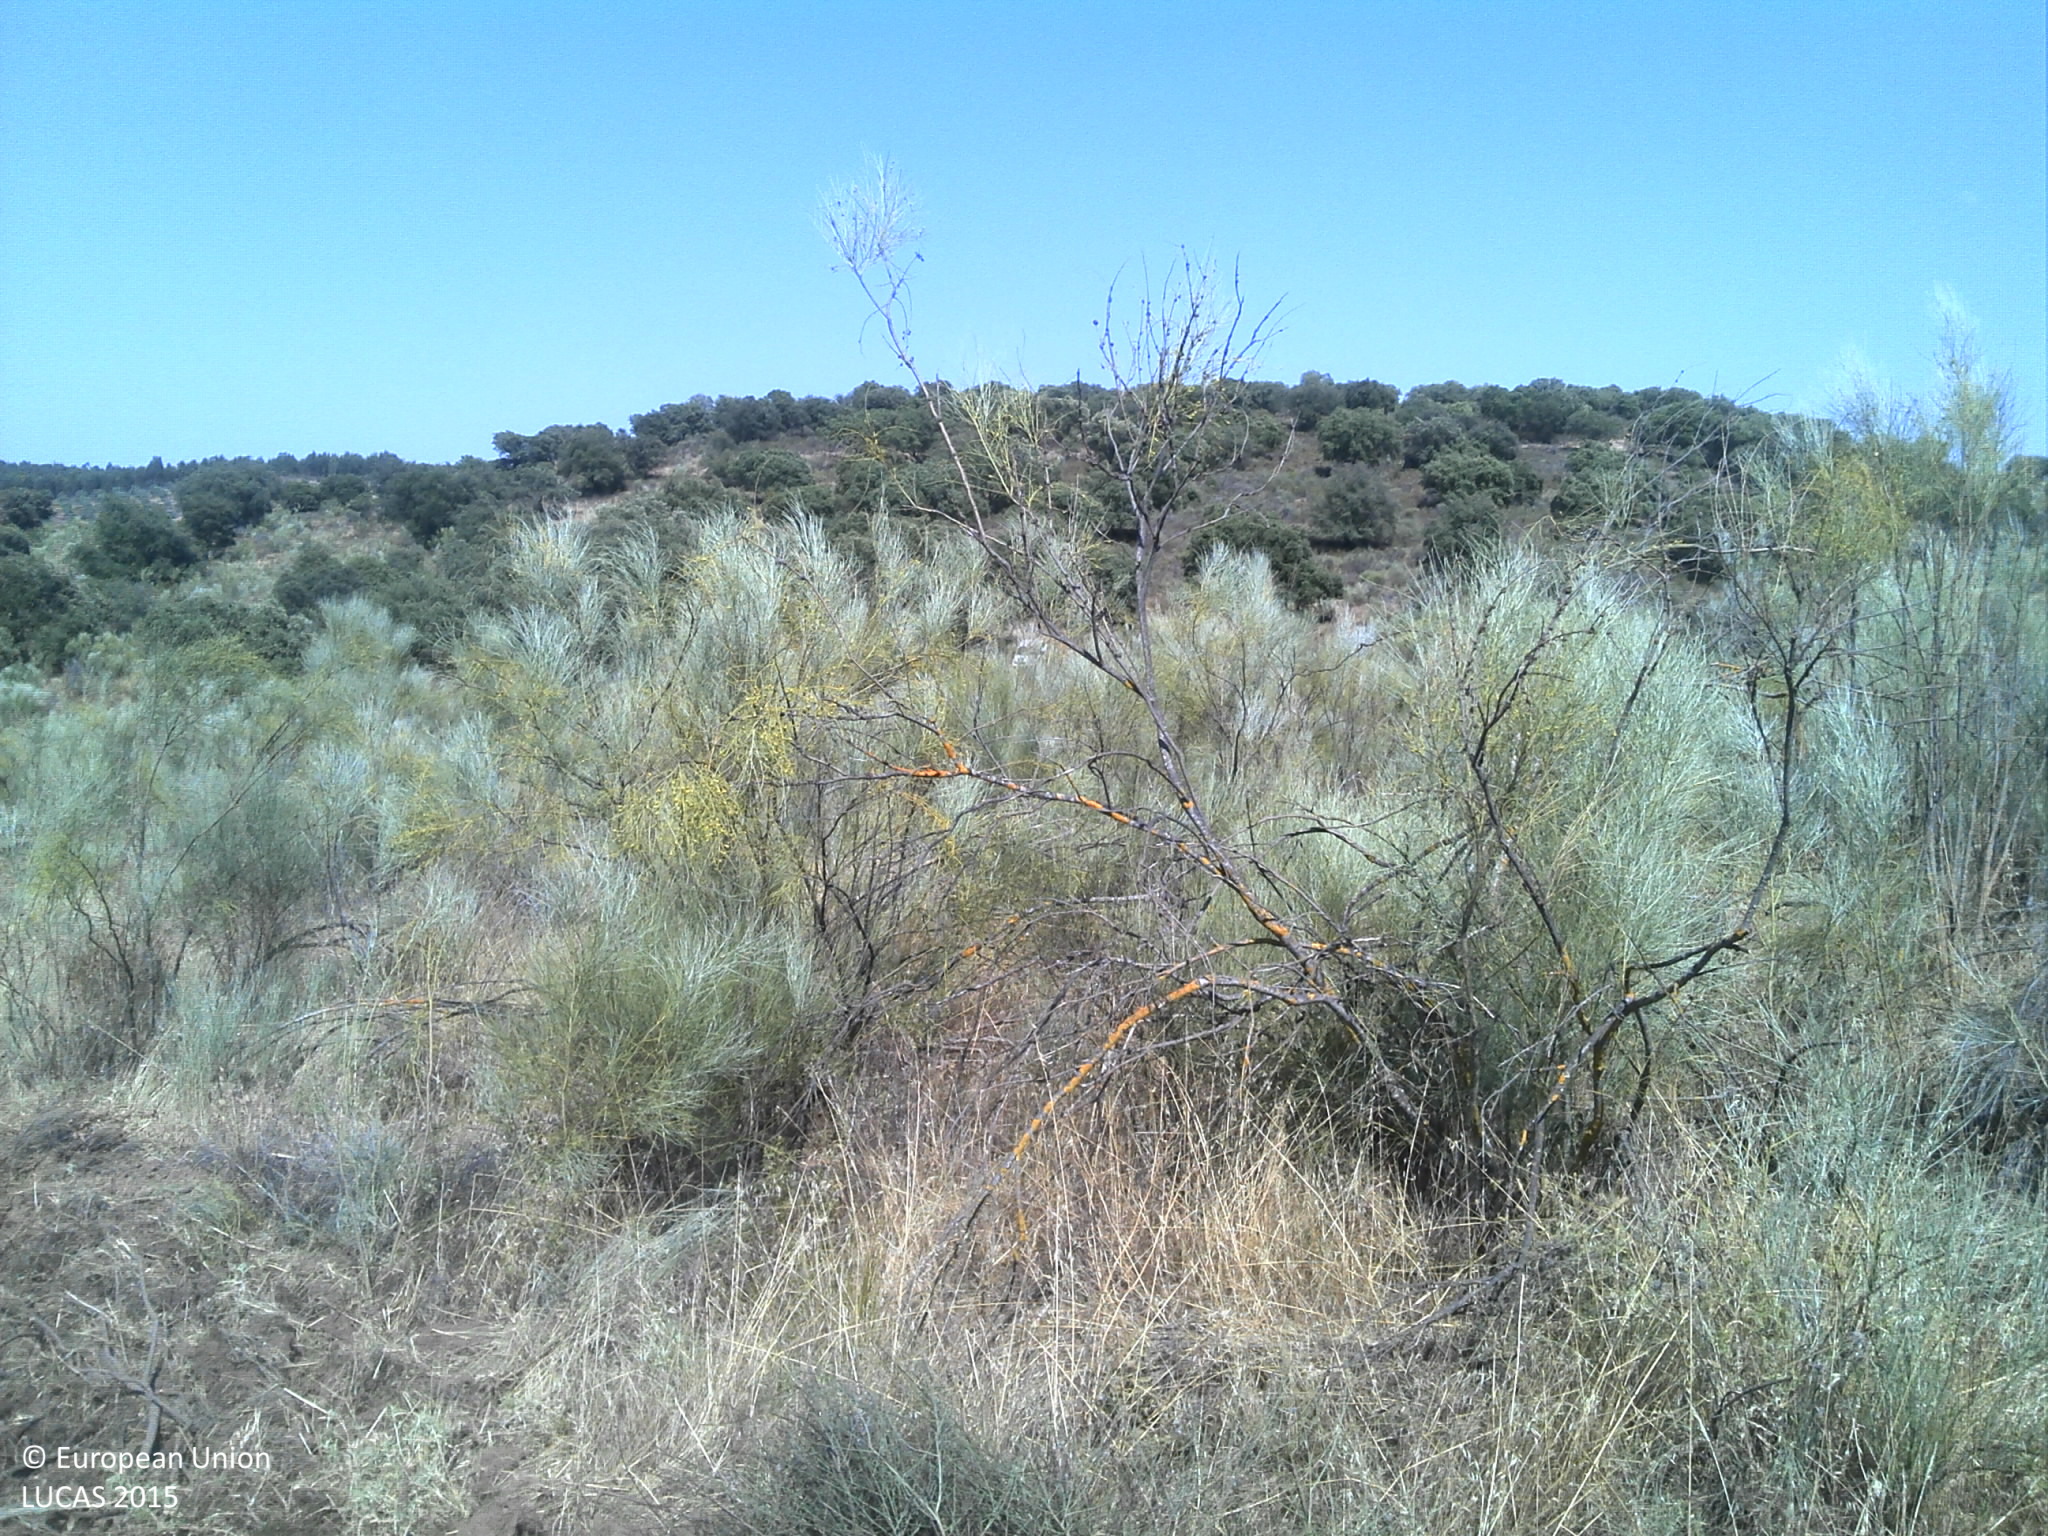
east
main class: Shrubland
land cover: Shrubland without tree cover
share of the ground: > 75 %
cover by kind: shrubs 75 %, herbaceous plants 20 %, unconsolidated bare surface 5 %
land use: Abandoned areas
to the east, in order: Shrubland without tree cover; Broadleaved woodland
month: June
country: PT
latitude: 39.7250
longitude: -7.1337
